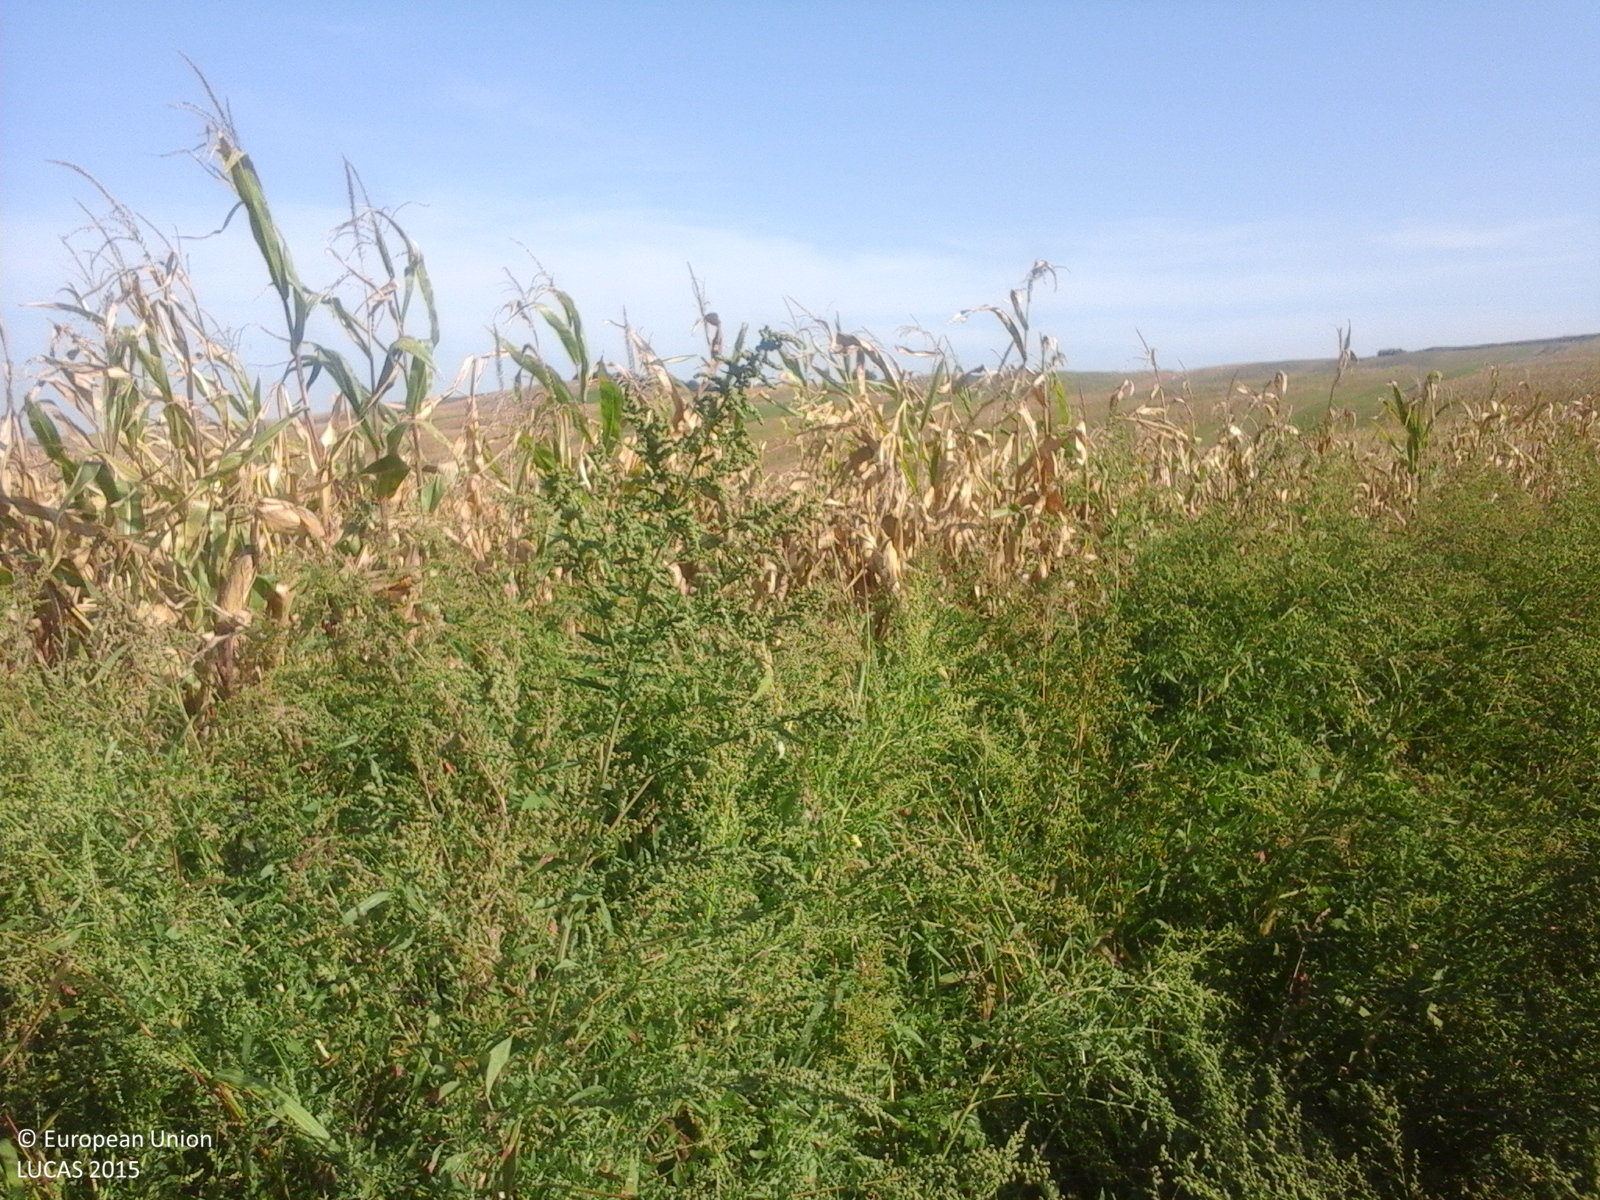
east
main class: Grassland
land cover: Spontaneously vegetated surfaces
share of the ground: > 75 %
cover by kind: herbaceous plants 100 %
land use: Fallow land
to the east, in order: Spontaneously vegetated surfaces; Maize; Lucerne; Maize; Sunflower; Grassland without tree/shrub cover; Maize; Sunflower; Shruby margins; Tracks; Grassland without tree/shrub cover
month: September
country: RO
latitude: 46.7481
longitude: 23.9395
